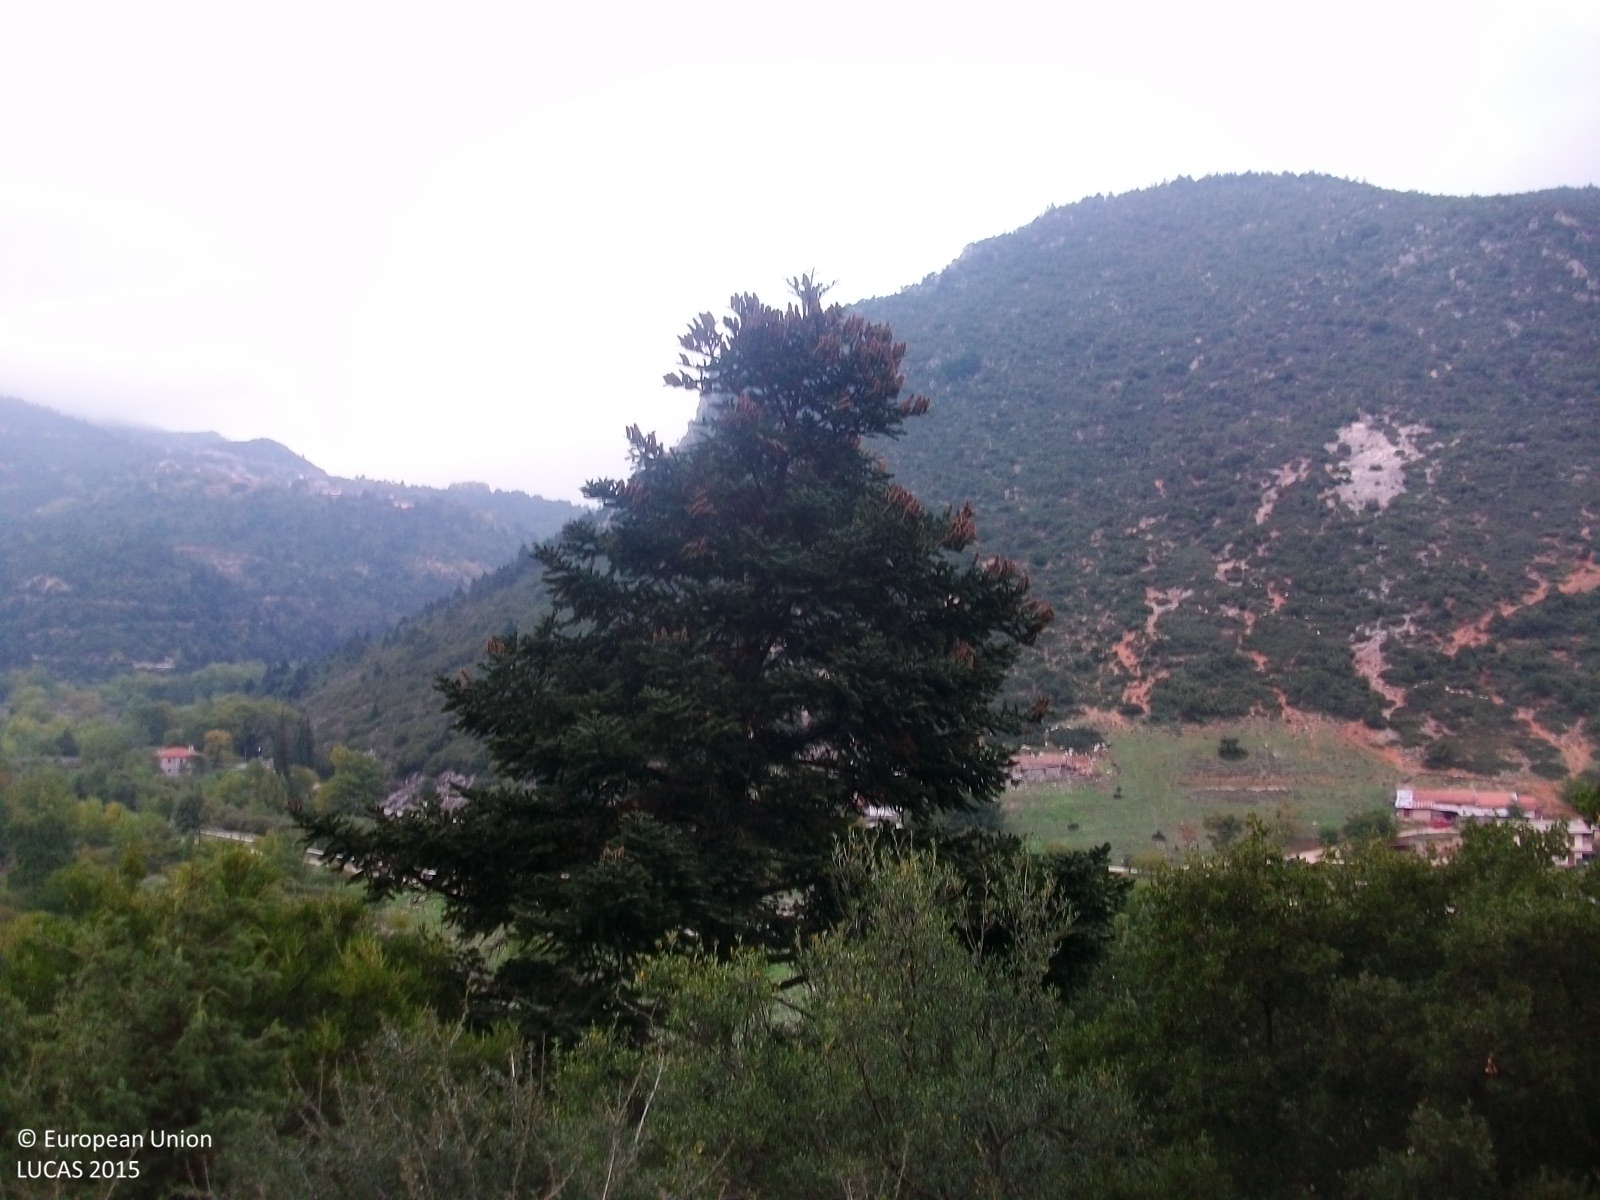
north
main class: Shrubland
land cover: Shrubland with sparse tree cover
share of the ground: 50 - 75 %
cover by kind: shrubs 50 %, herbaceous plants 40 %, broadleaved forest trees 5 %, unconsolidated bare surface 5 %
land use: Semi-natural and natural areas not in use
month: October
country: GR
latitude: 37.8502
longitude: 22.3884
